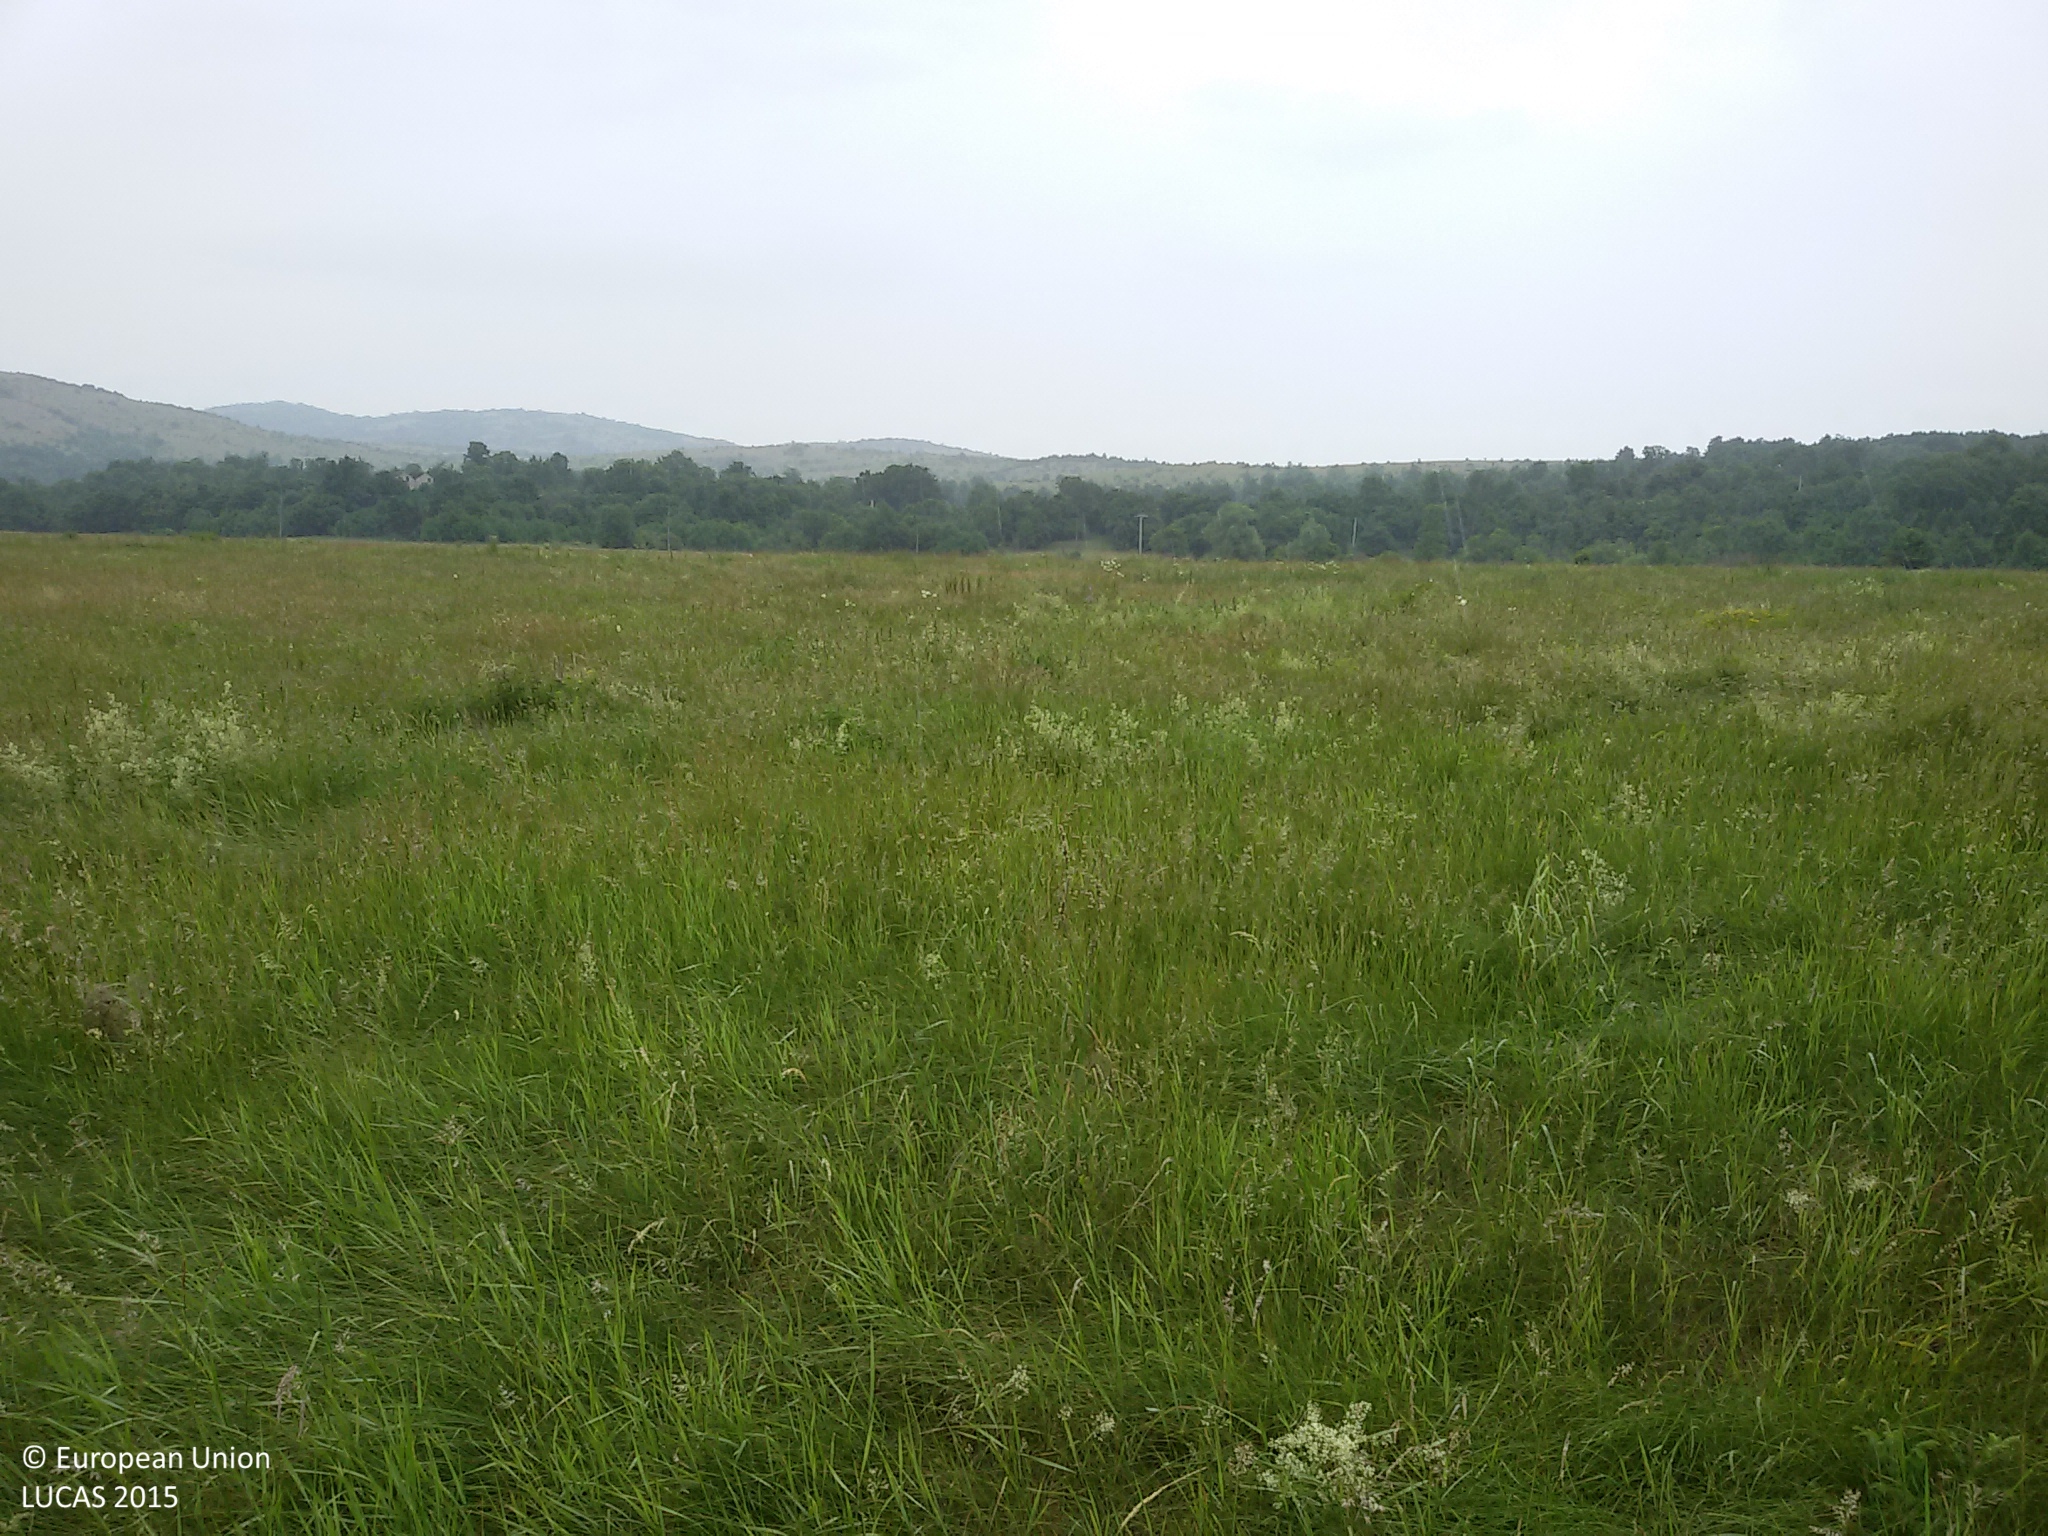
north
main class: Grassland
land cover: Grassland without tree/shrub cover
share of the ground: > 75 %
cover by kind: herbaceous plants 95 %, unconsolidated bare surface 5 %
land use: Agriculture (excluding fallow land and kitchen gardens)
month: June
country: HR
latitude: 44.6136
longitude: 15.6266
